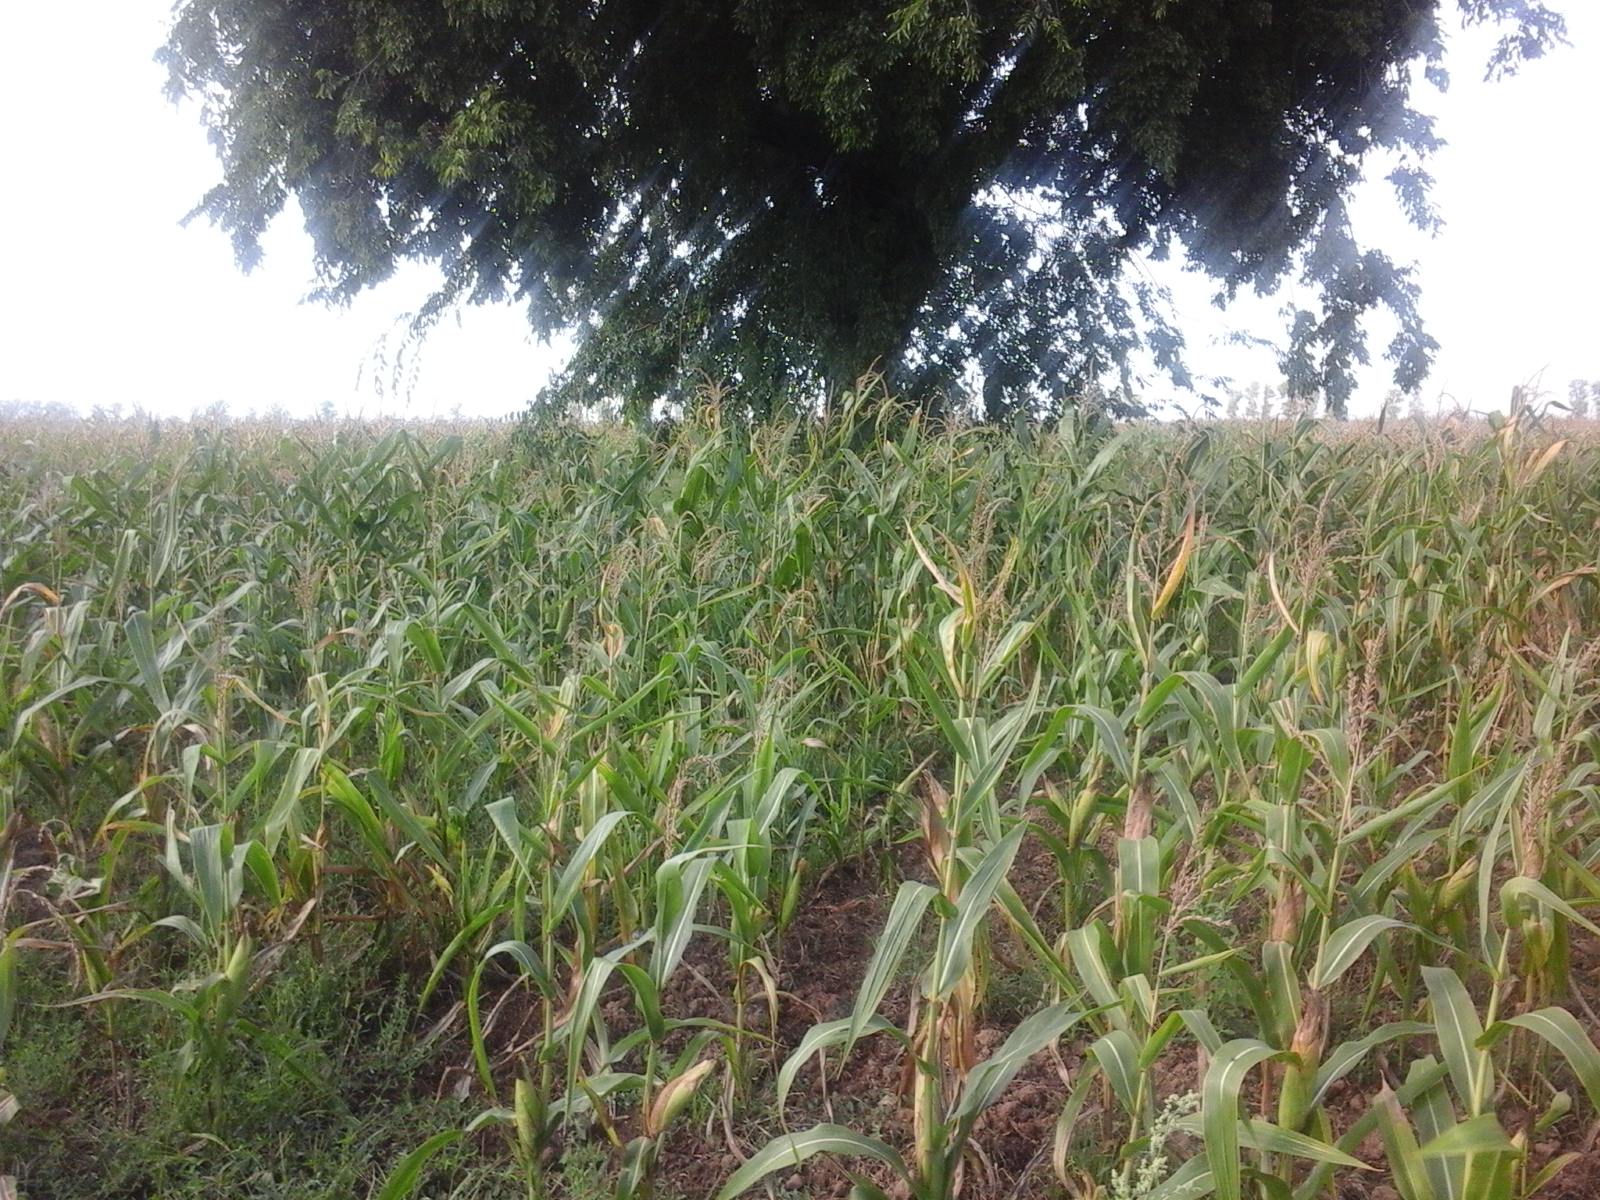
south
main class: Cropland
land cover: Maize
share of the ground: > 75 %
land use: Agriculture (excluding fallow land and kitchen gardens)
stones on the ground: < 10 %
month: August
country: RO
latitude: 46.4702
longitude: 21.5375
